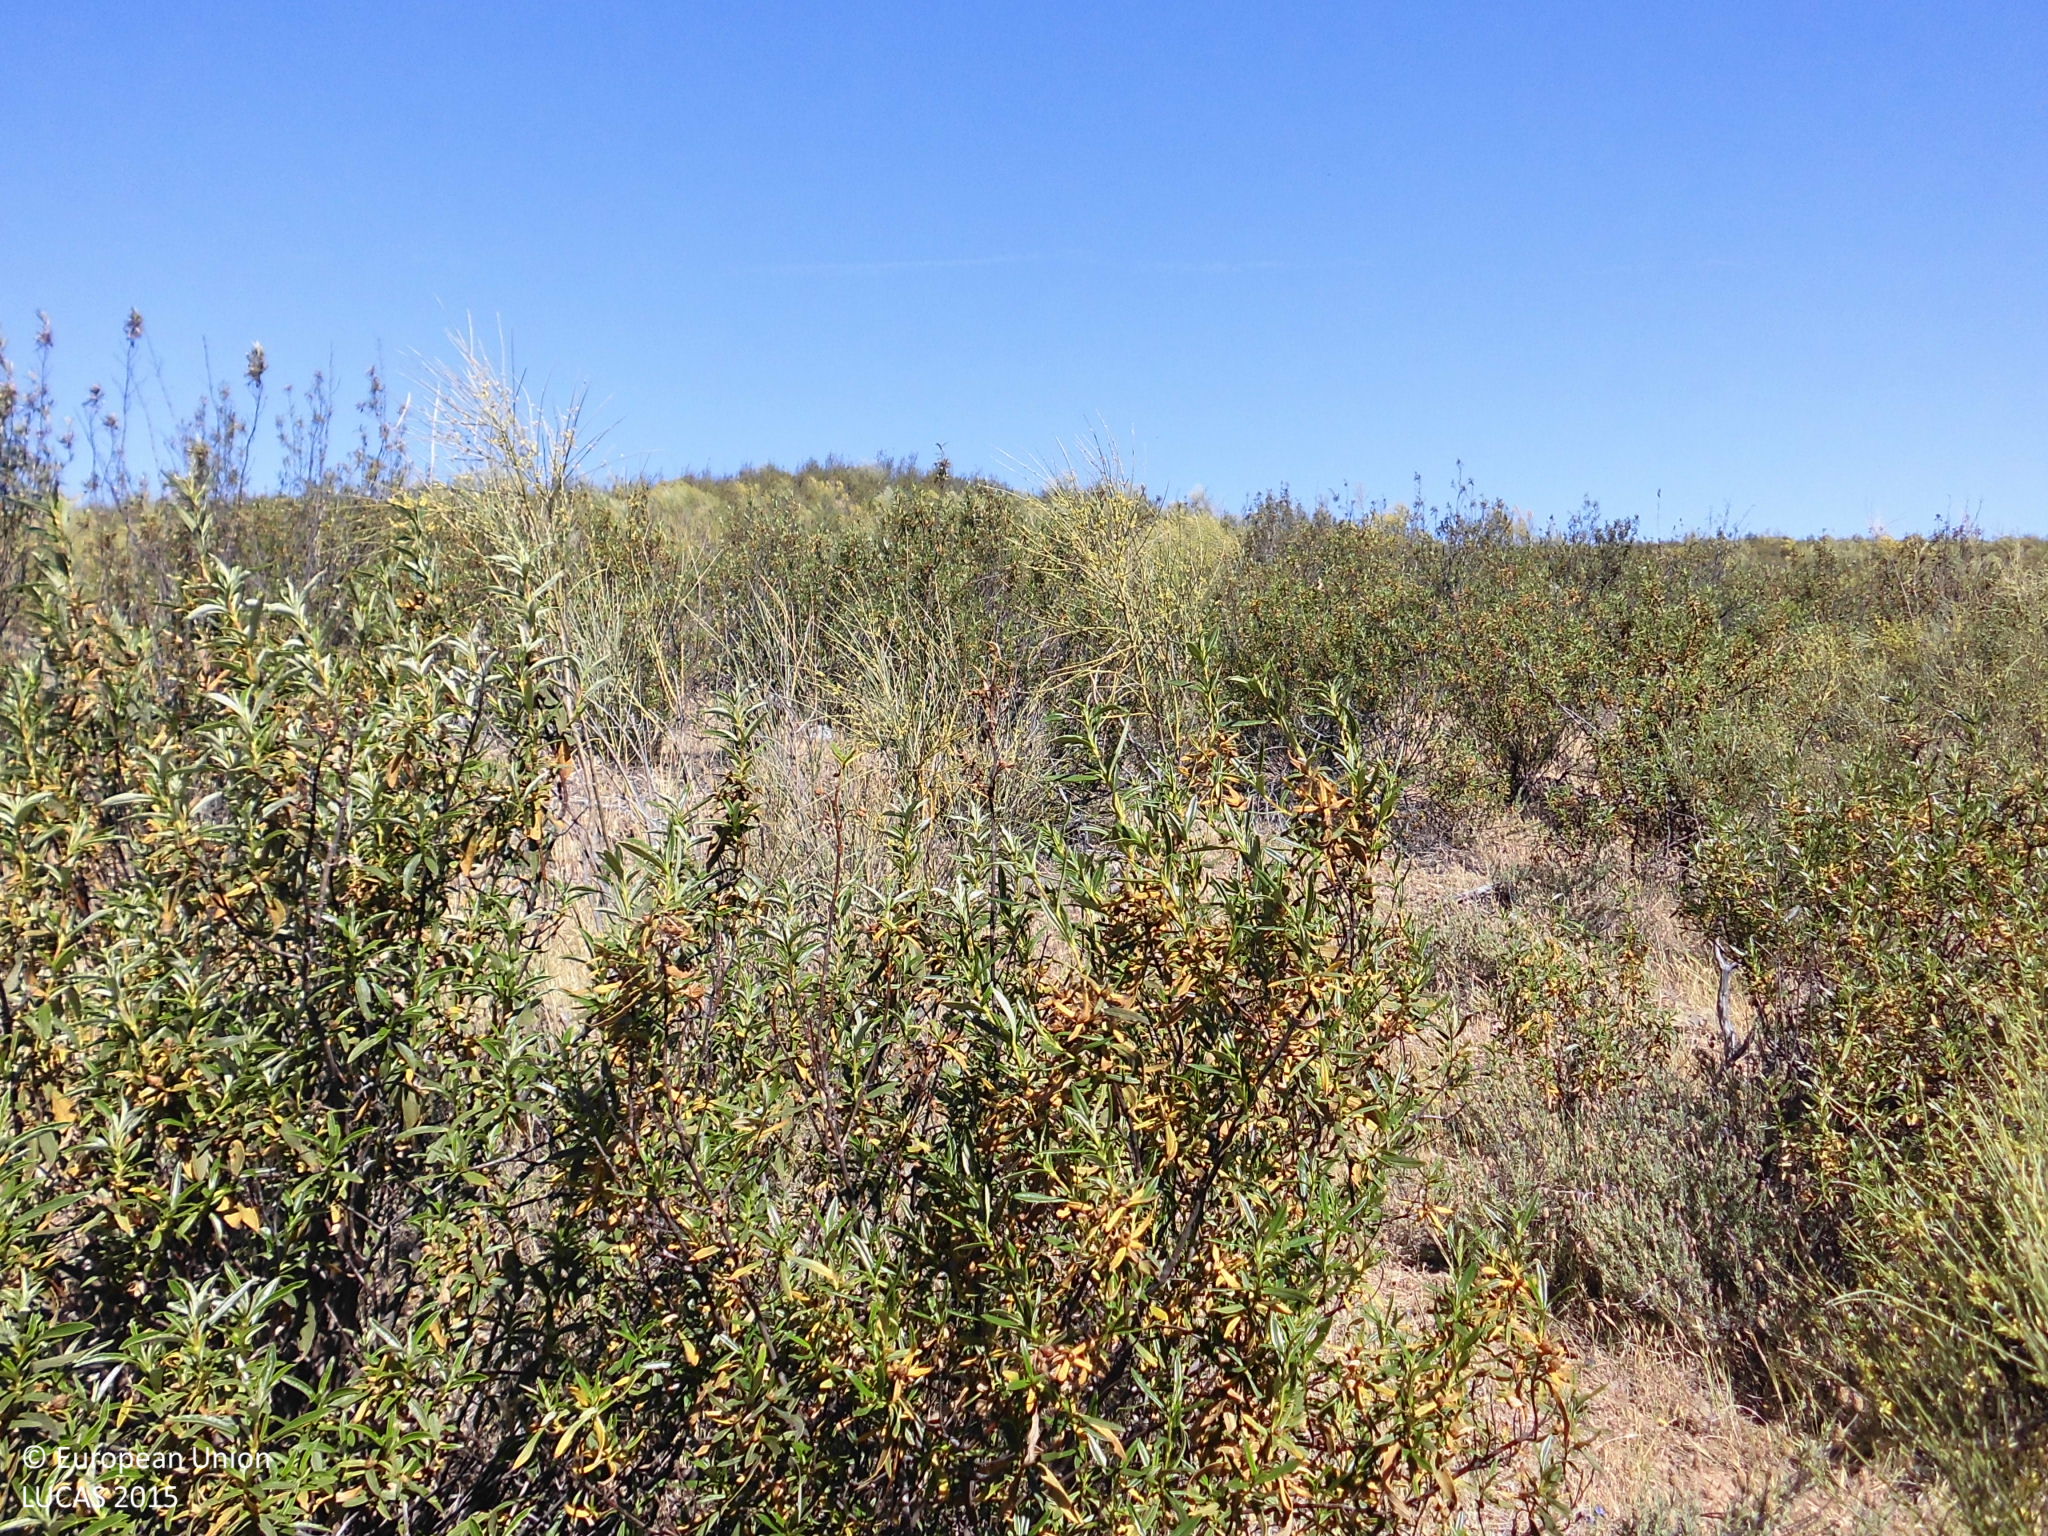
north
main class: Shrubland
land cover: Shrubland without tree cover
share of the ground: 50 - 75 %
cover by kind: shrubs 55 %, herbaceous plants 45 %
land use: Semi-natural and natural areas not in use
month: May
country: ES
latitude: 39.4772
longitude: -6.9720
